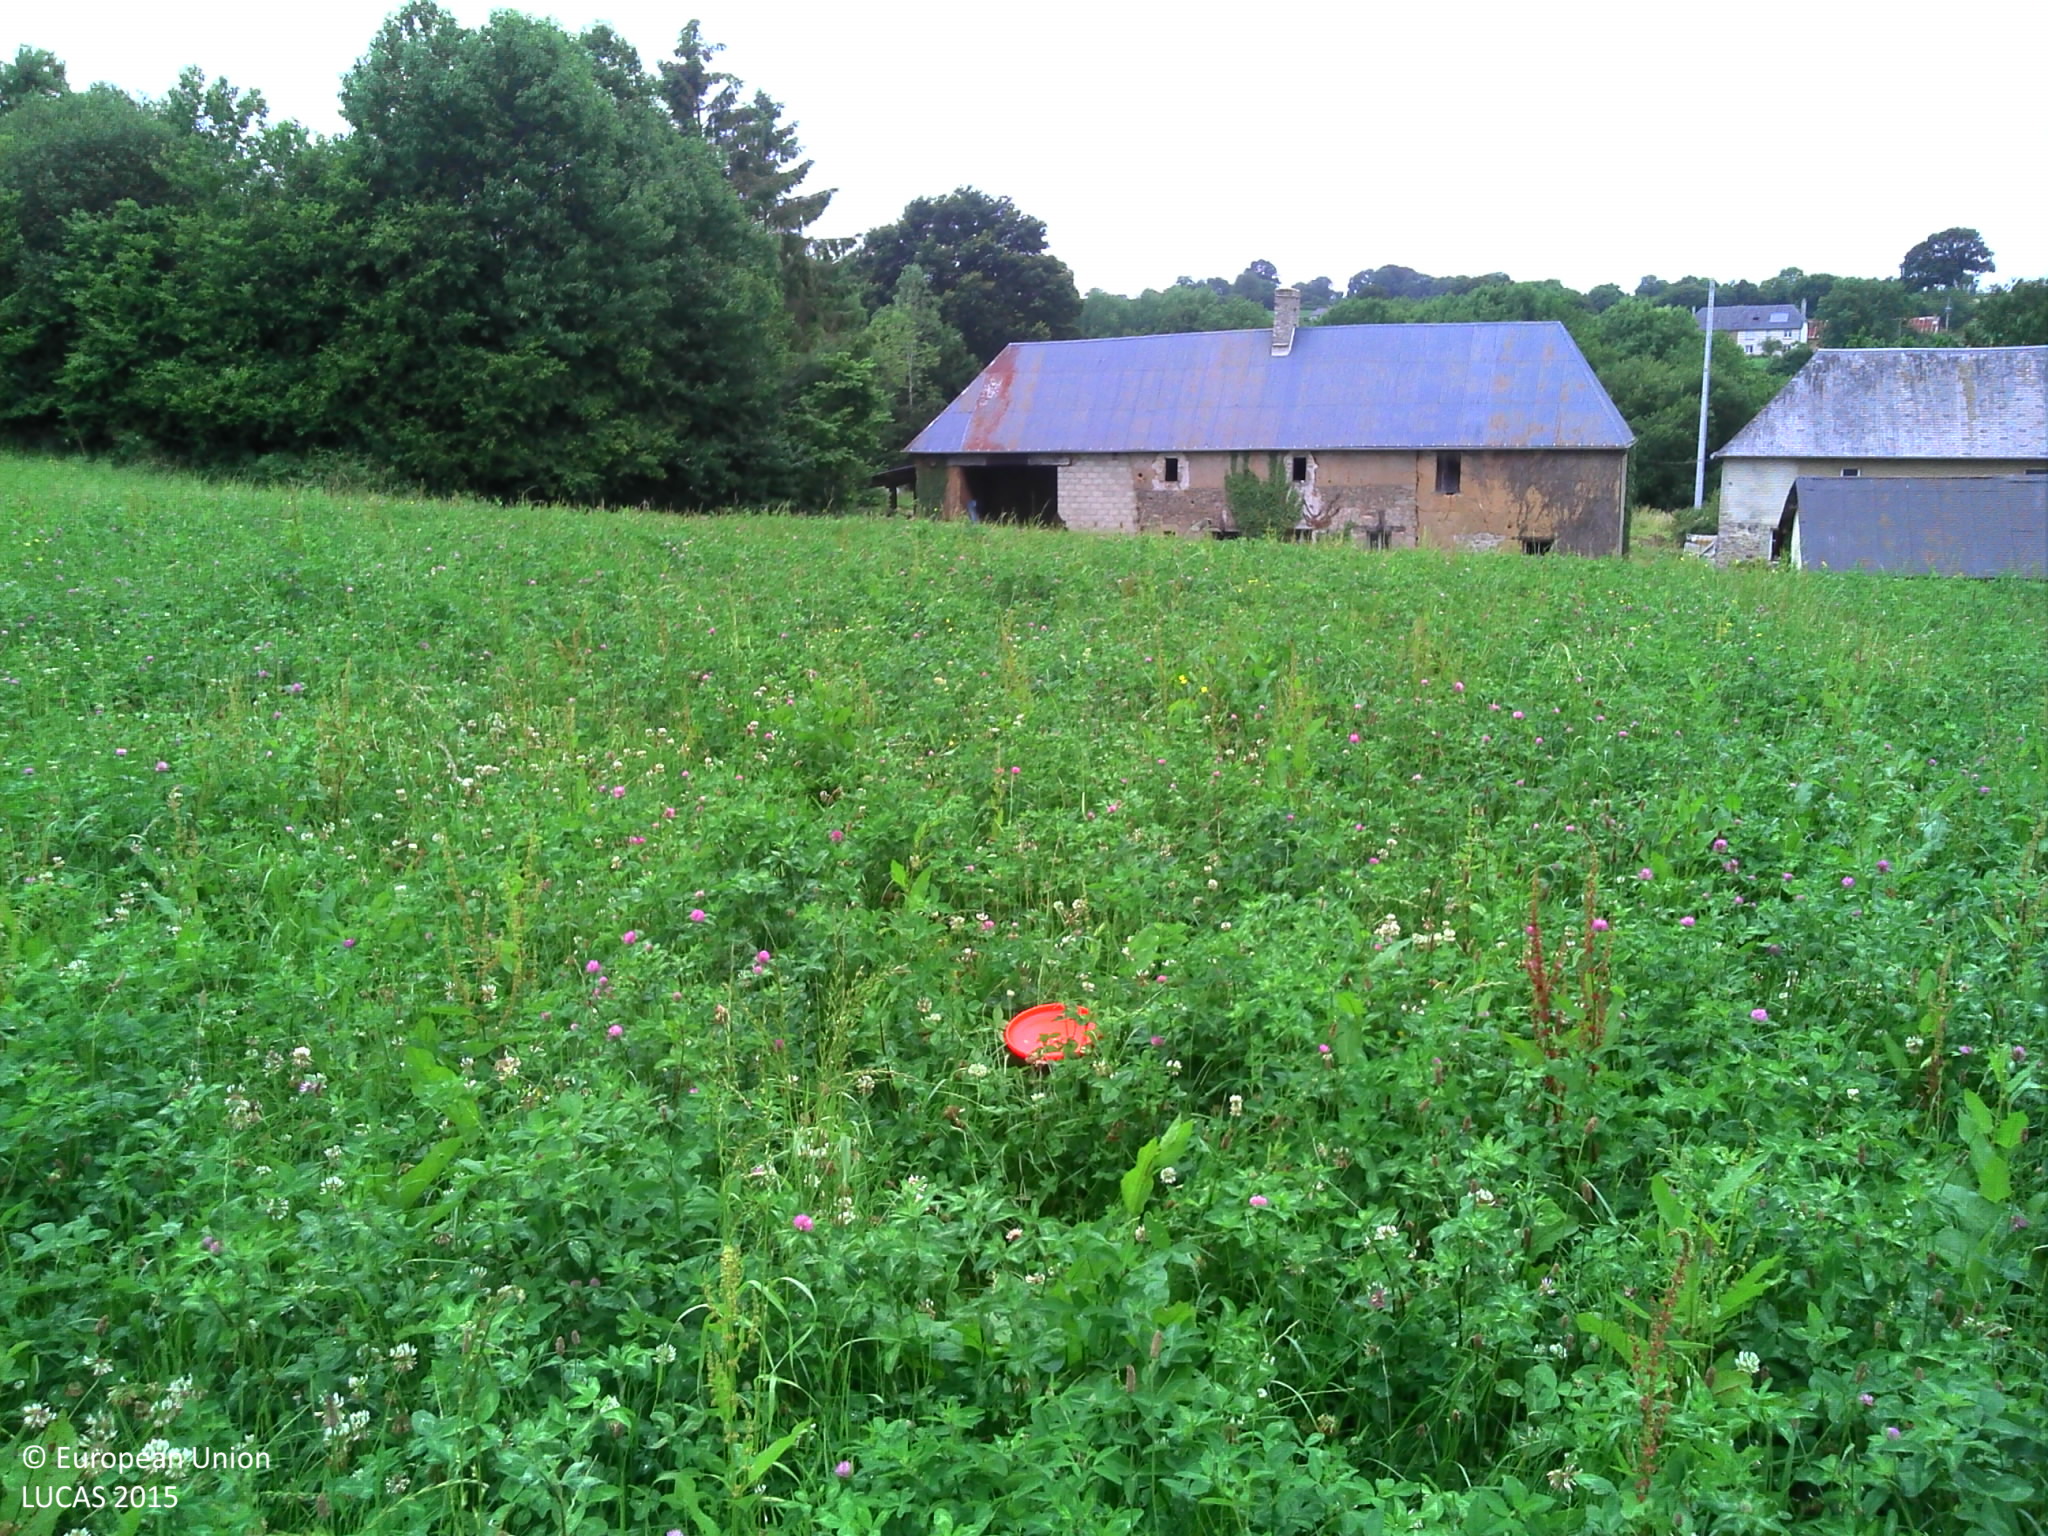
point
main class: Cropland
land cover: Other leguminous and mixtures for fodder
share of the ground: > 75 %
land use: Agriculture (excluding fallow land and kitchen gardens)
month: July
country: FR
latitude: 49.1275
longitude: -1.3247
